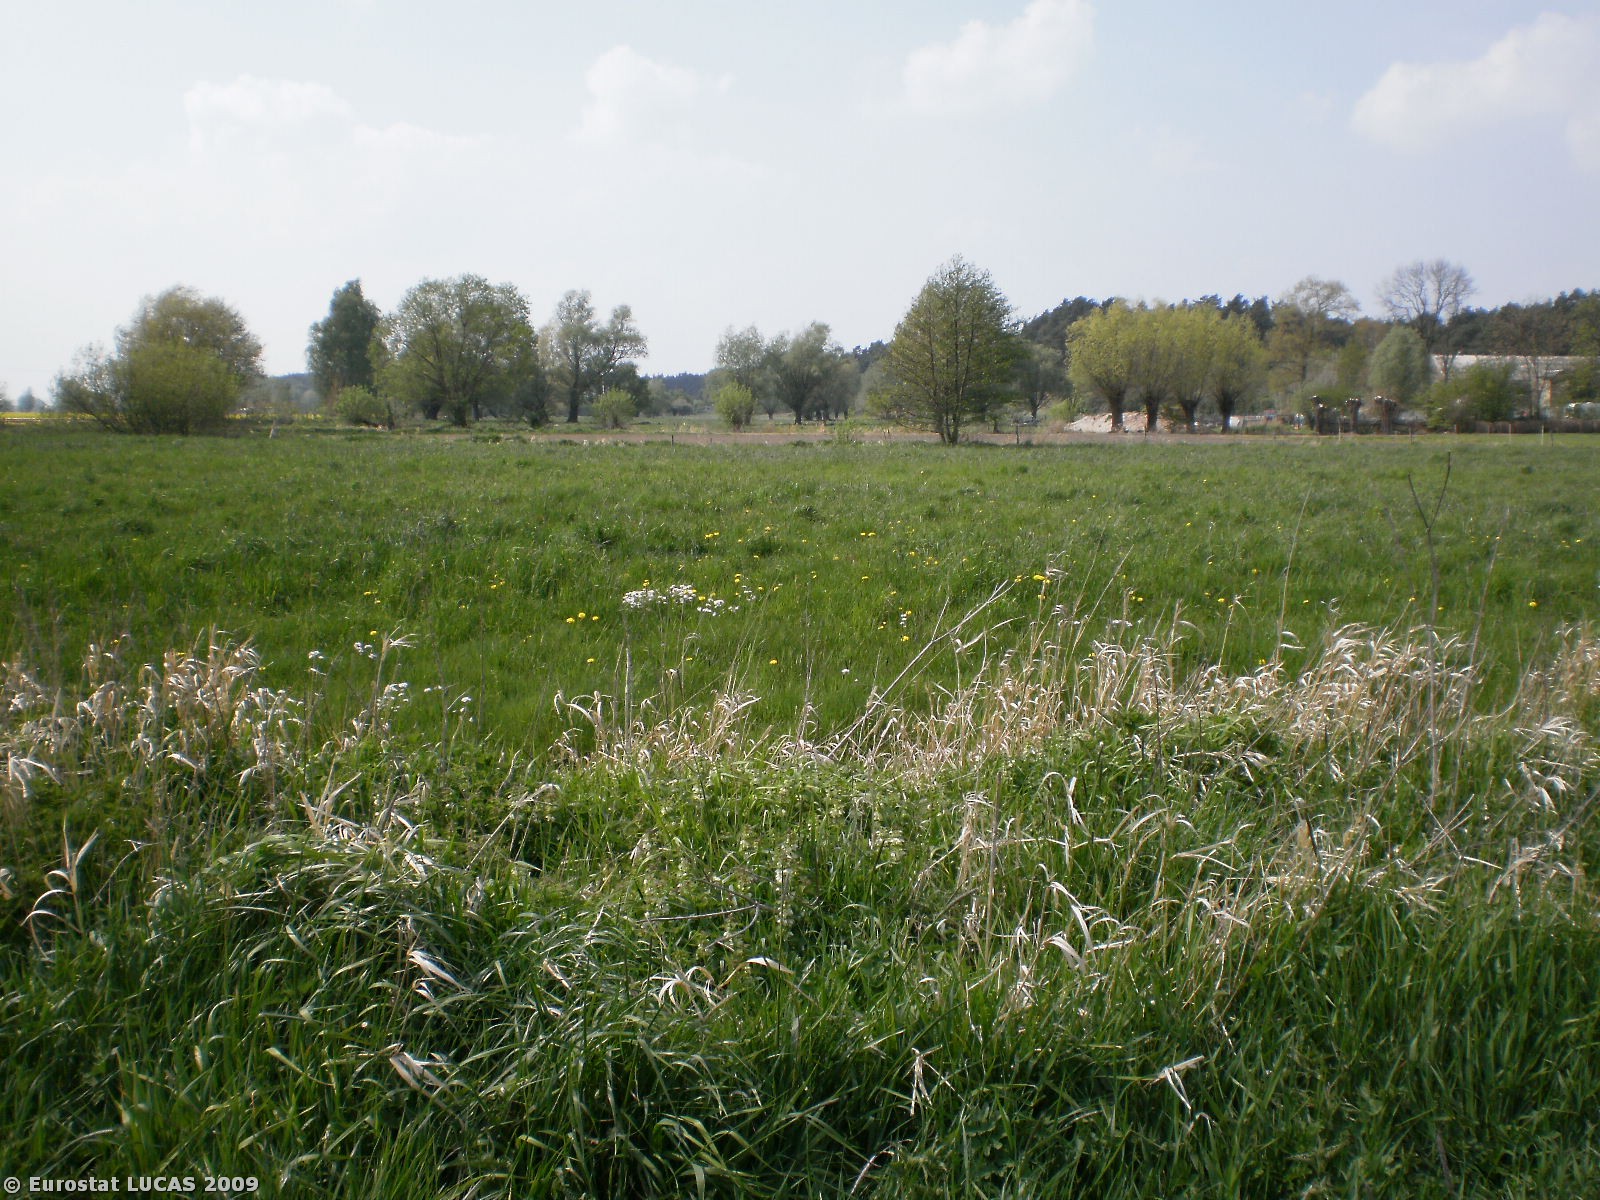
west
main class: Grassland
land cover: Grassland without tree/shrub cover
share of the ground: > 75 %
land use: Agriculture (excluding fallow land and kitchen gardens)
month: May
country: PL
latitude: 54.3315
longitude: 19.0175
